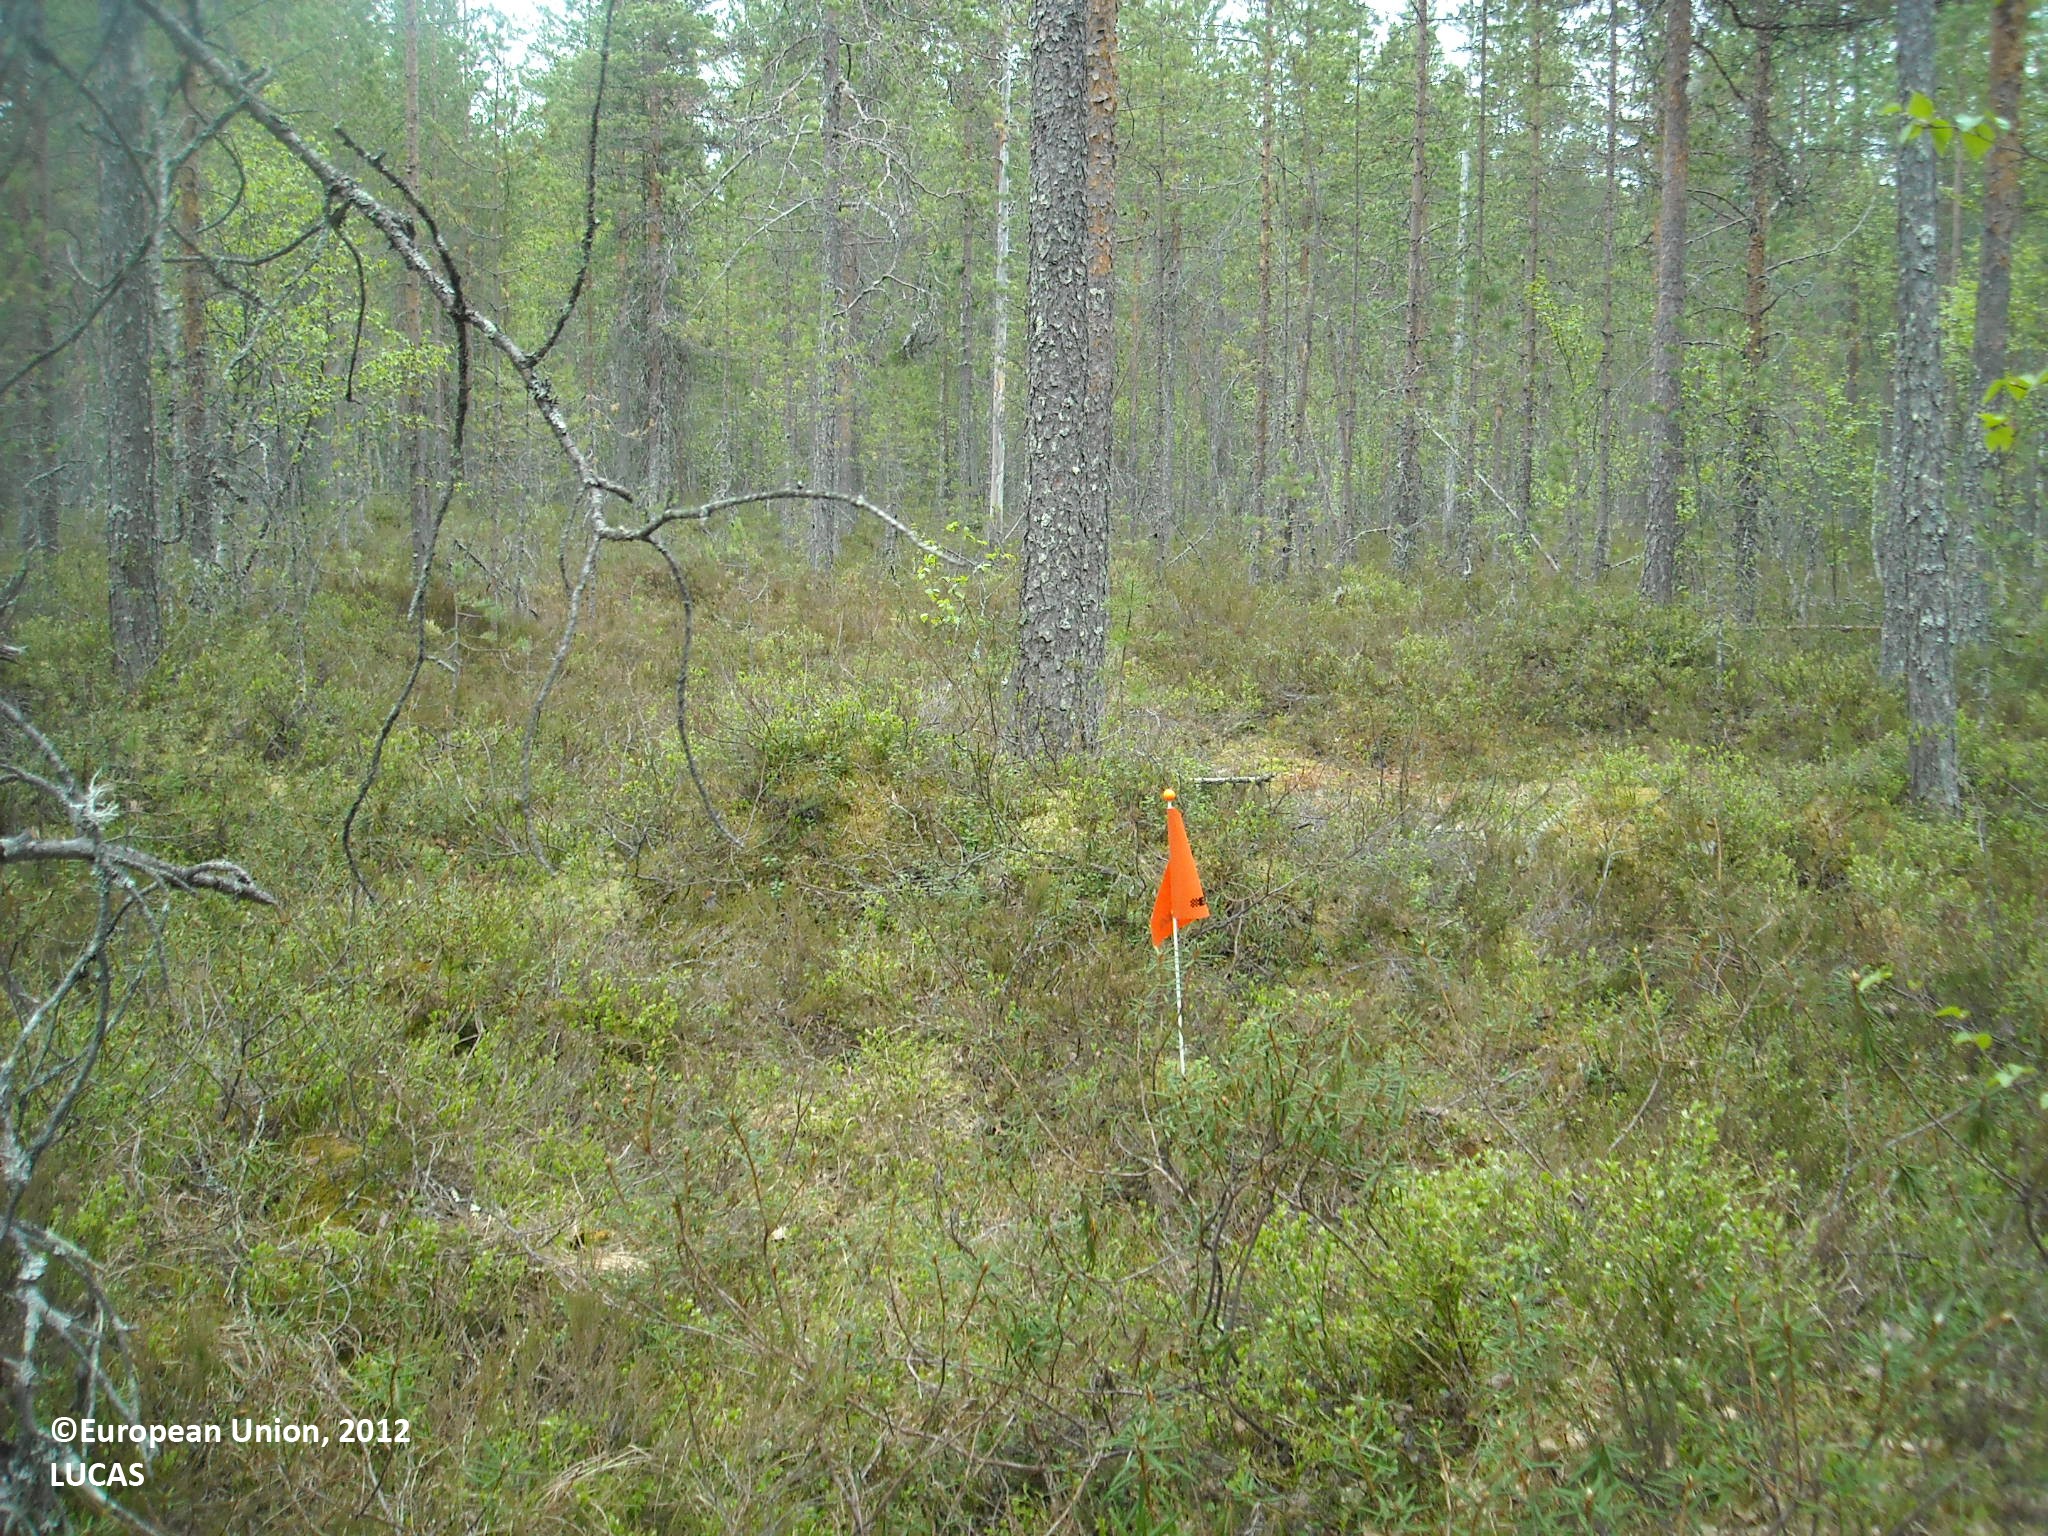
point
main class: Woodland
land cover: Pine dominated coniferous woodland
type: mire and swamp forests
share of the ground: > 75 %
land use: Forestry
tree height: > 5 m
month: June
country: FI
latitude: 64.6432
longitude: 27.3177
